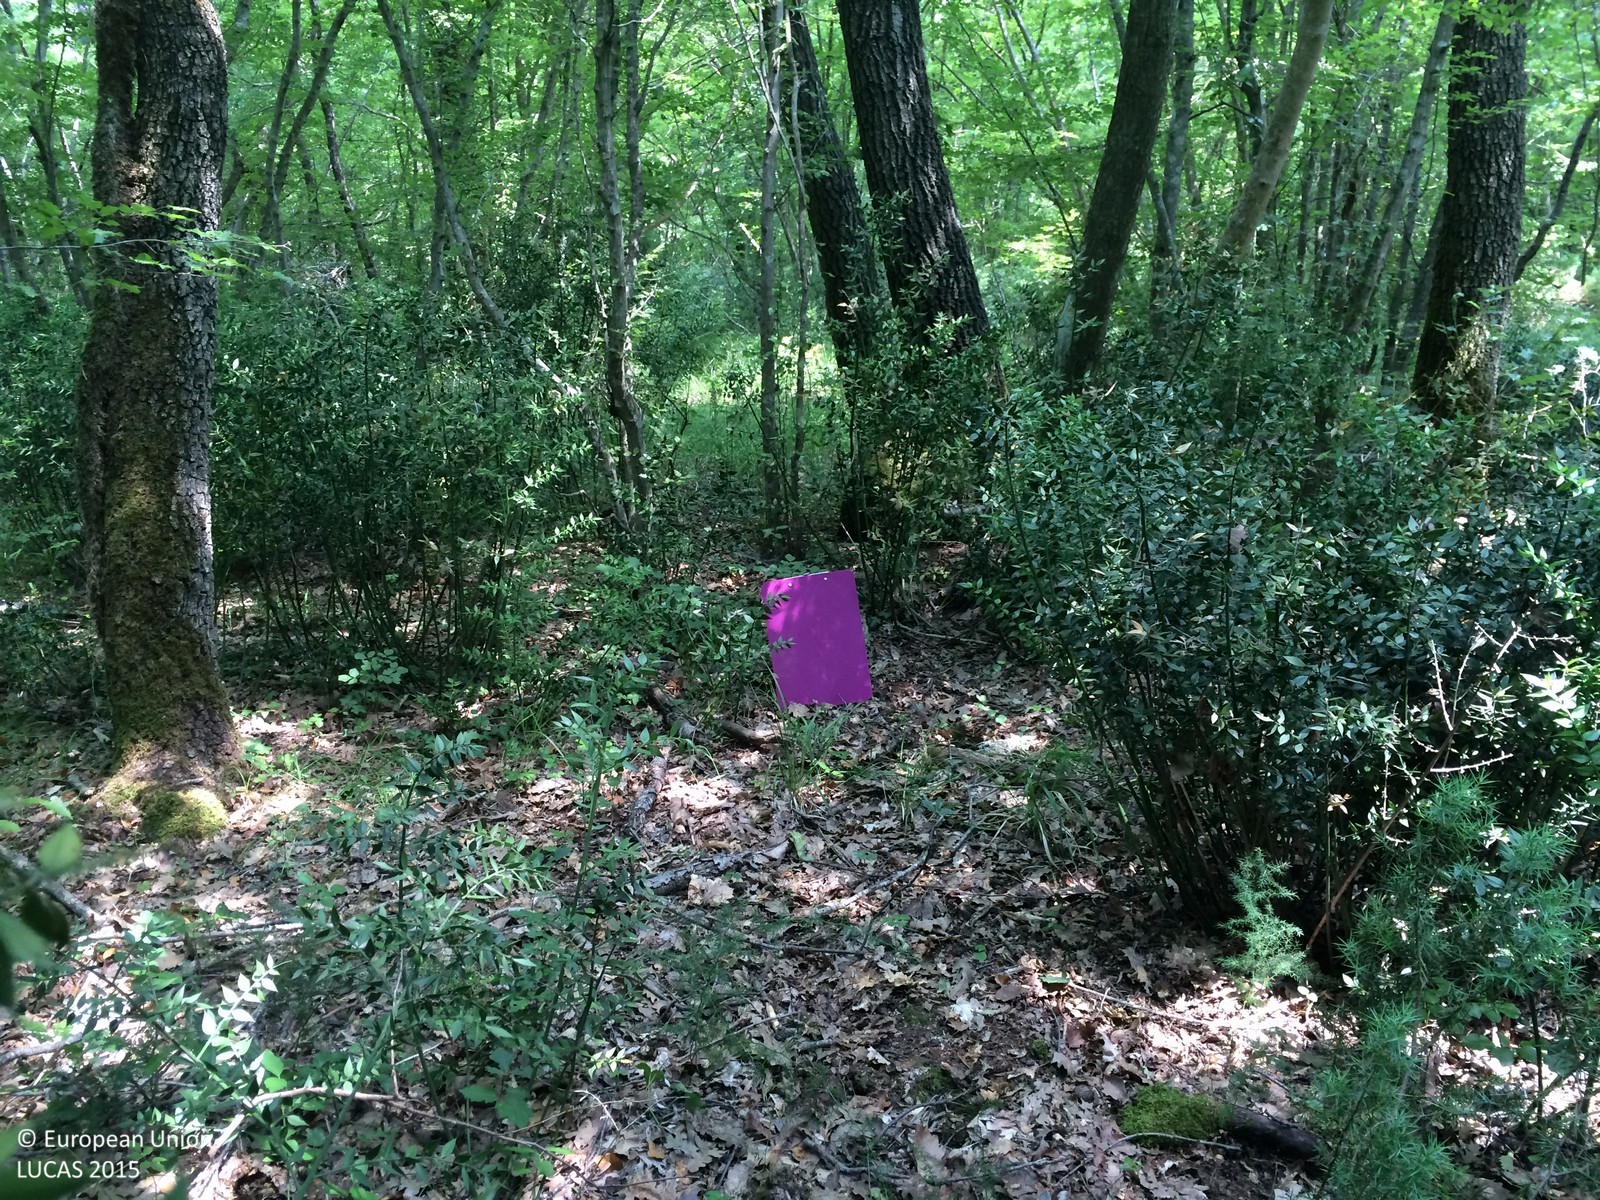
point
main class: Woodland
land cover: Broadleaved woodland
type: beech forest
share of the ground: > 75 %
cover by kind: broadleaved forest trees 90 %, shrubs 10 %
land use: Semi-natural and natural areas not in use
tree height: > 5 m
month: June
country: HR
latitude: 45.1114
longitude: 13.7950
